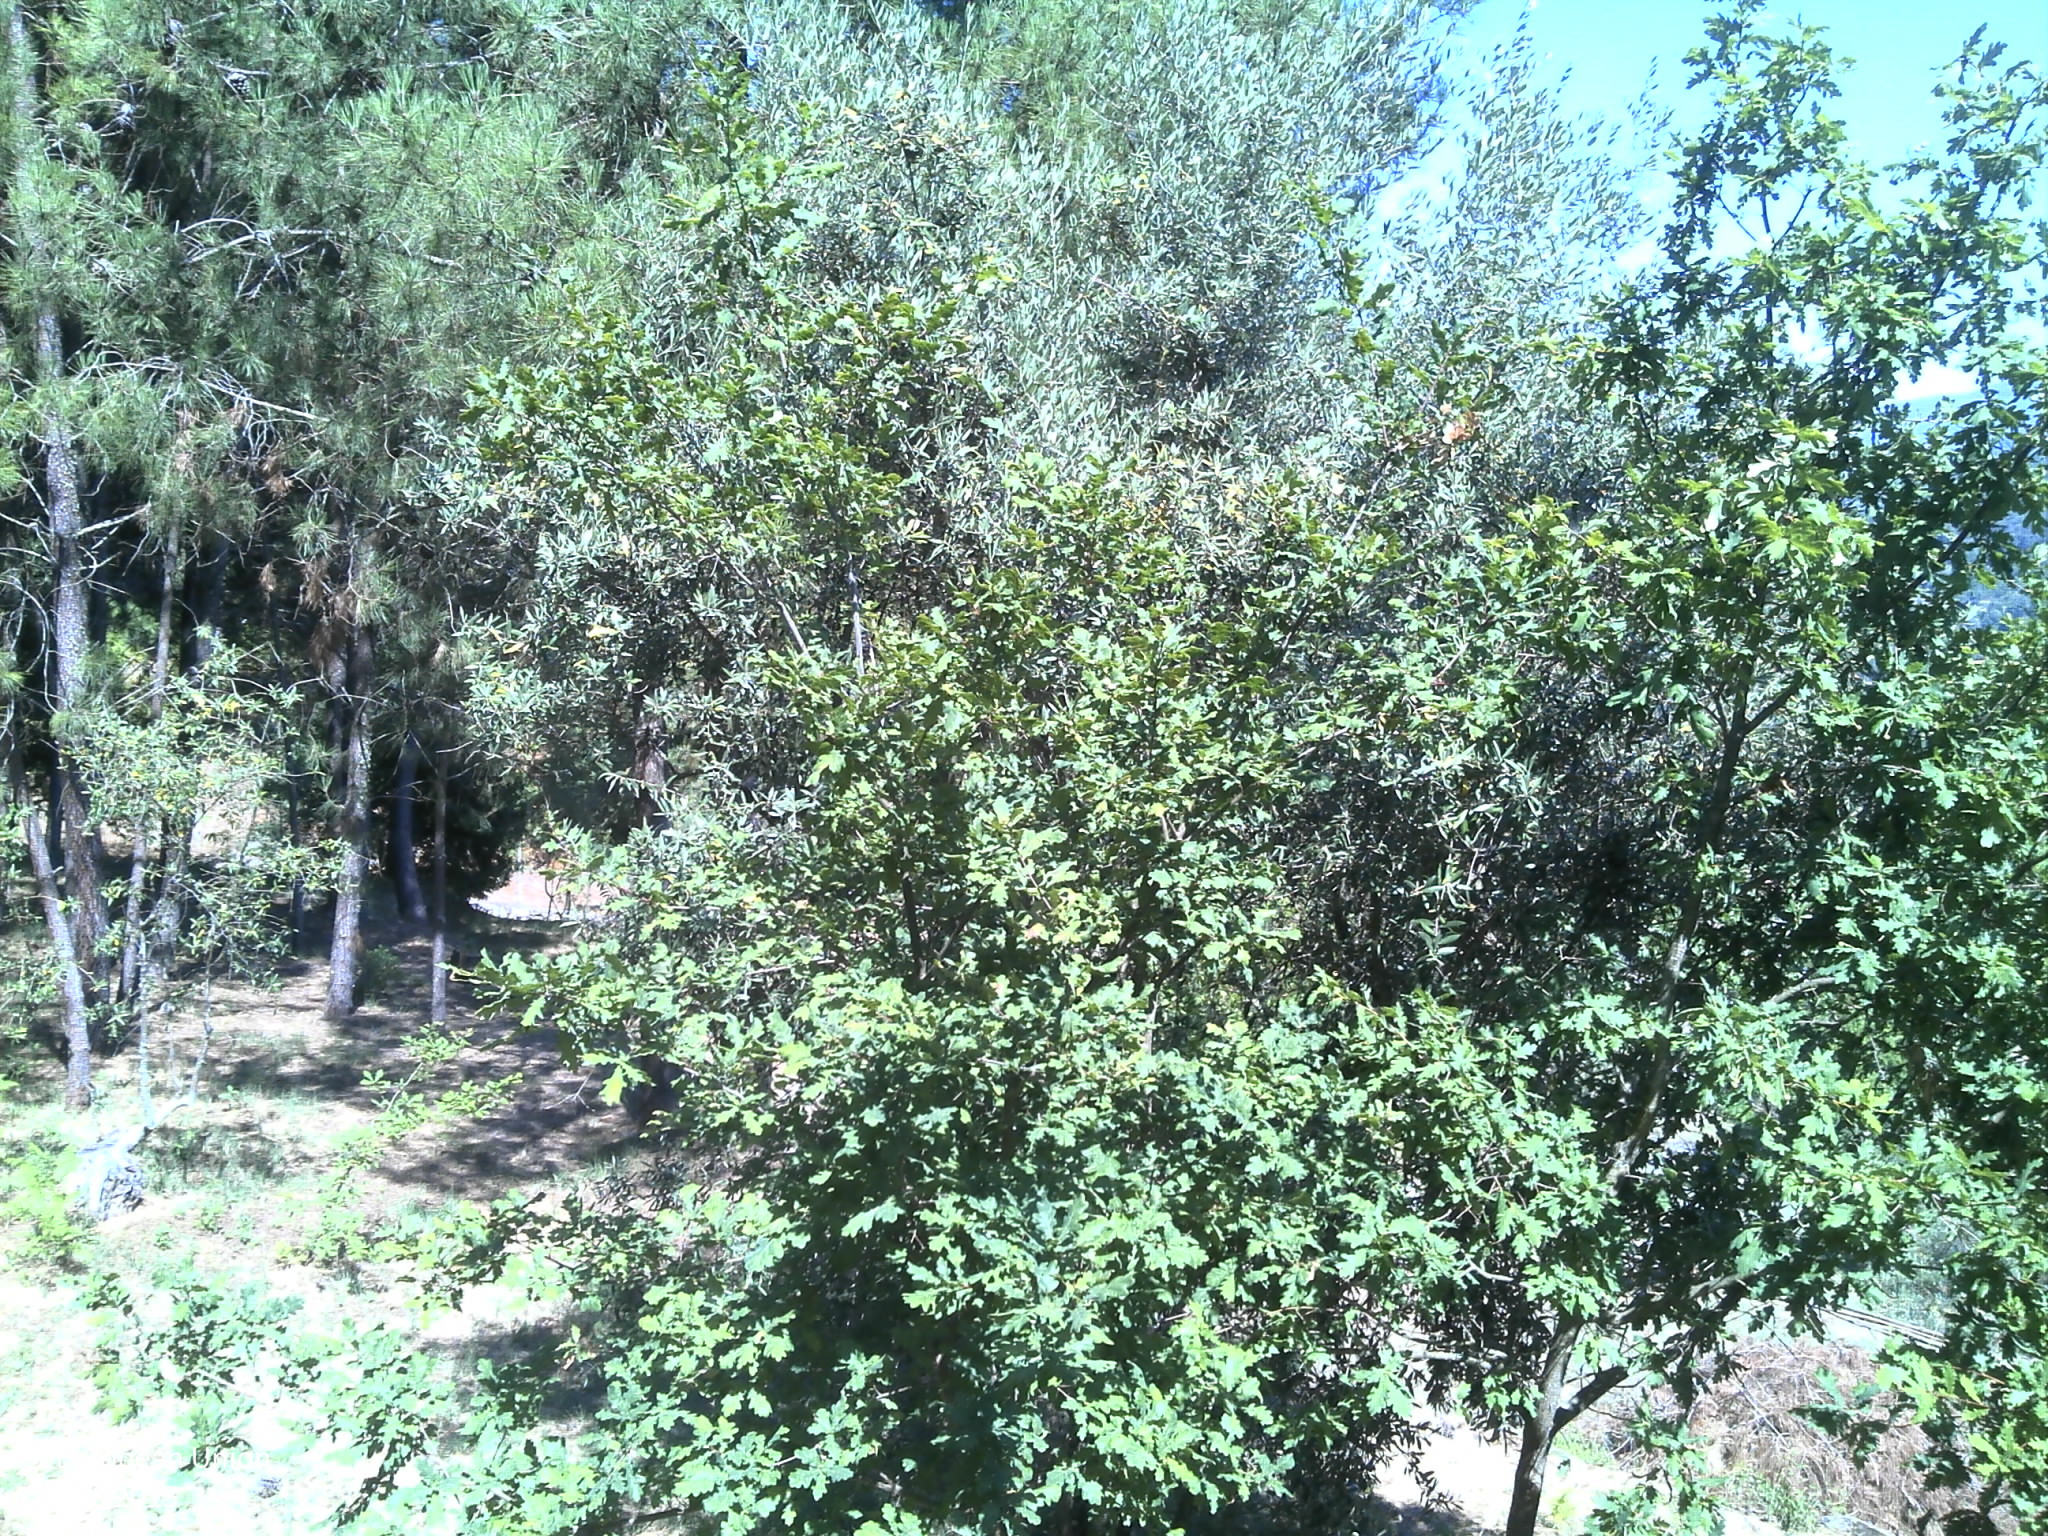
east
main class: Woodland
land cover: Broadleaved woodland
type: thermophilous deciduous forest
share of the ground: 25 - 50 %
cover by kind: broadleaved forest trees 45 %, herbaceous plants 40 %, consolidated bare surface 10 %, shrubs 5 %
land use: Forestry
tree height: < 5 m
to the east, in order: Broadleaved woodland; Pine dominated coniferous woodland; Dry stone walls; Grassland with sparse tree/shrub cover; Dry stone walls; Olive groves; Fences; Pine dominated coniferous woodland; Fences; Tracks; Shrubland with sparse tree cover; Tracks; Shrubland with sparse tree cover
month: July
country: PT
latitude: 40.3062
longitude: -7.8962
